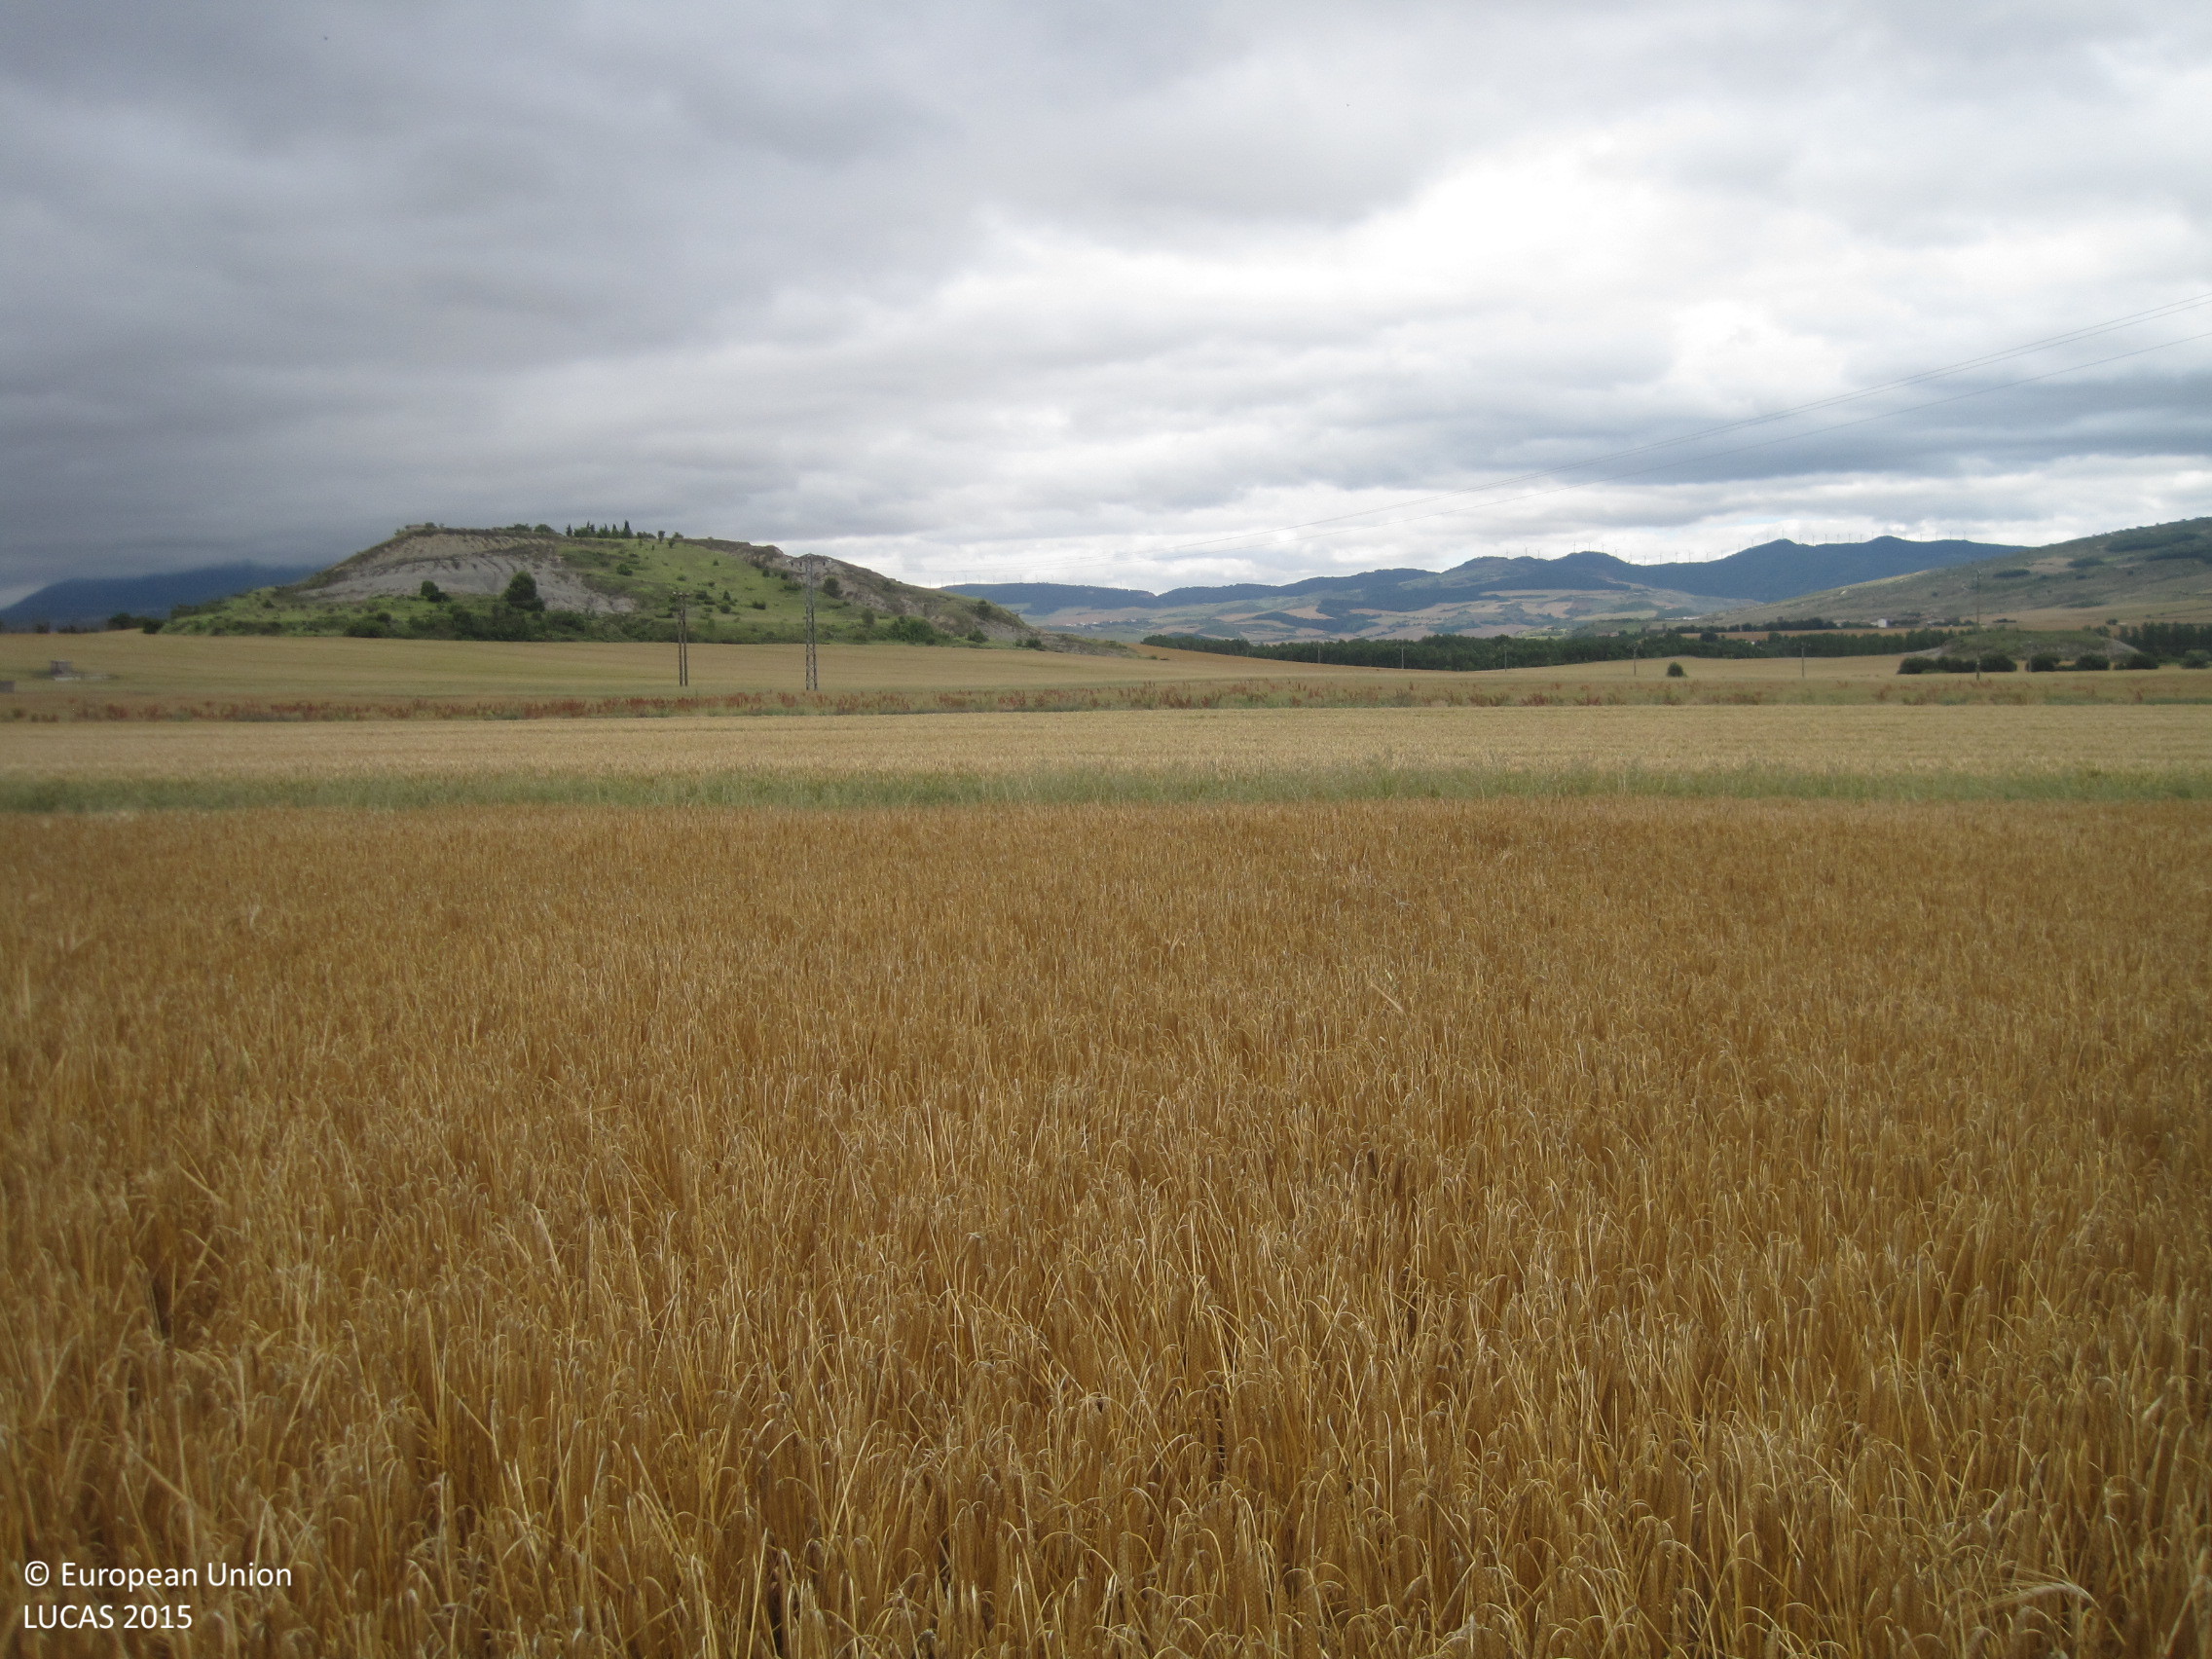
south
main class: Cropland
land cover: Barley
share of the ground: > 75 %
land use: Agriculture (excluding fallow land and kitchen gardens)
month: June
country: ES
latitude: 42.8397
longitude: -1.7740
